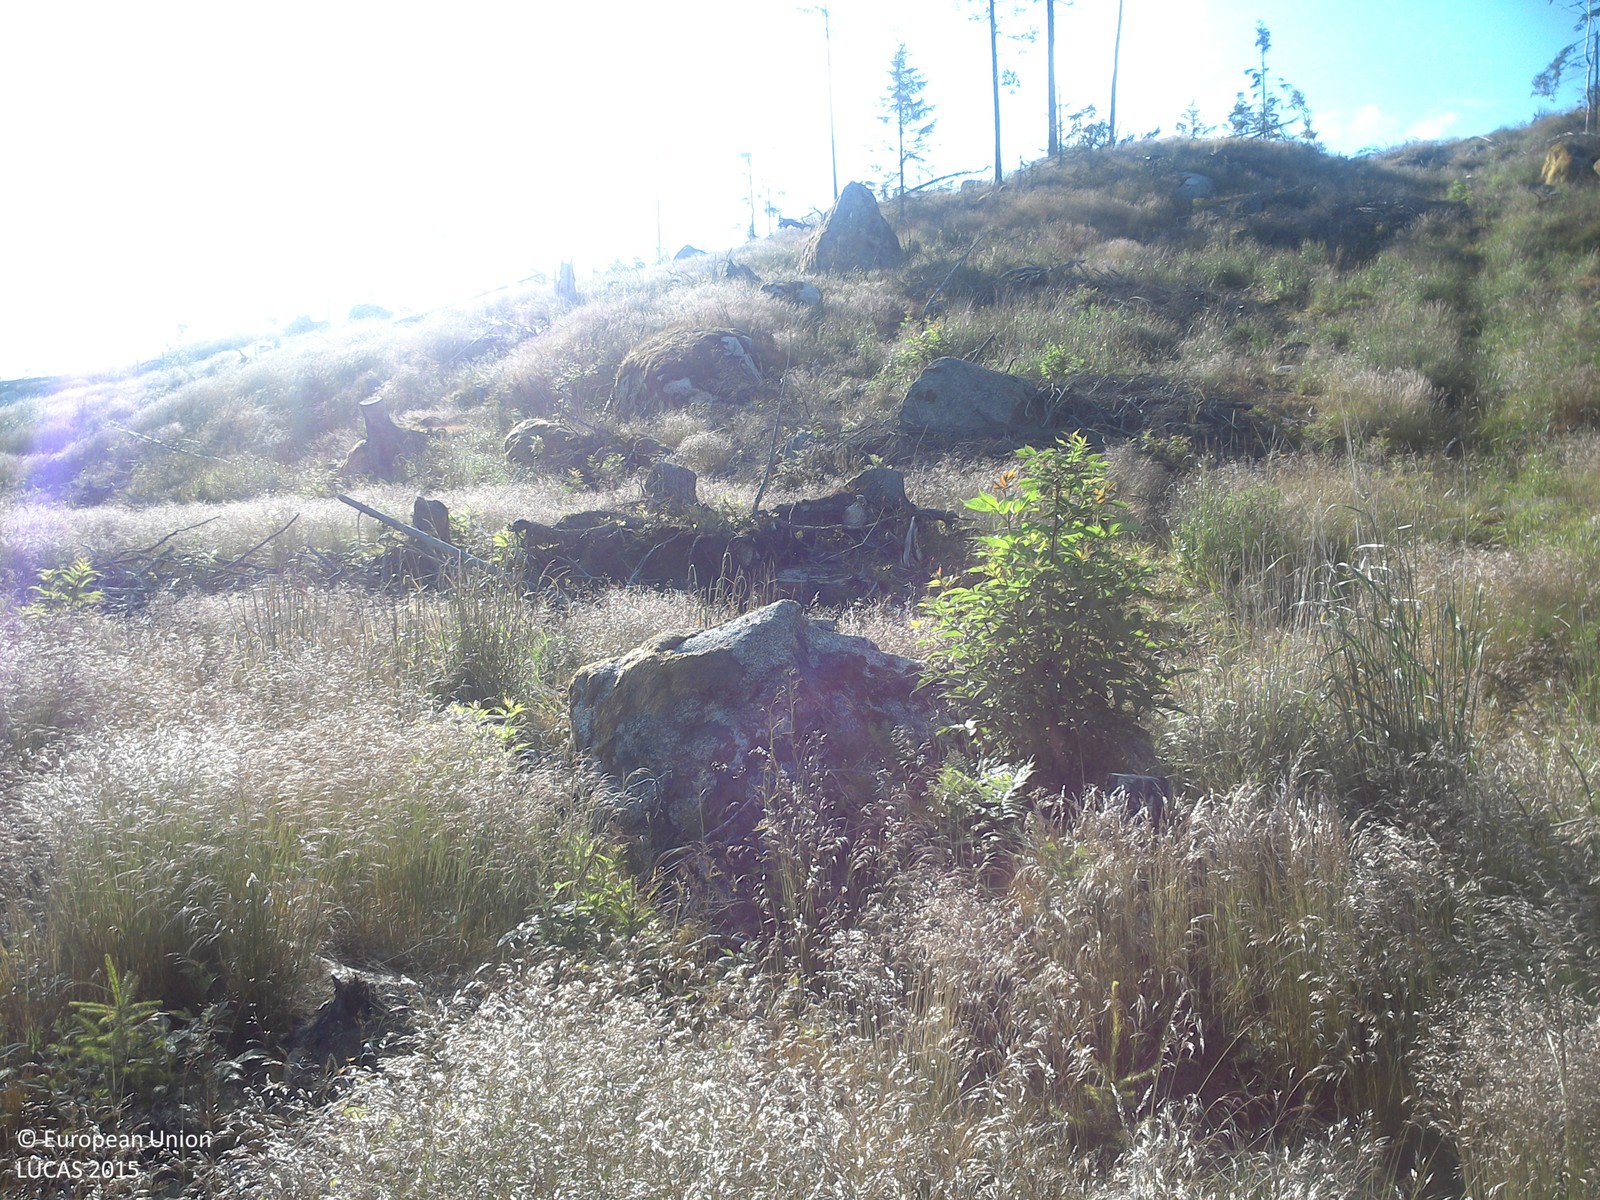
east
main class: Grassland
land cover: Grassland with sparse tree/shrub cover
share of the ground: > 75 %
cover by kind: herbaceous plants 90 %, coniferous forest trees 5 %, shrubs 5 %
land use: Forestry
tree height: < 5 m
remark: Clear cut
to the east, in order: Grassland with sparse tree/shrub cover; Spruce dominated coniferous woodland
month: June
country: SE
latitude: 58.1010
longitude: 15.6455
